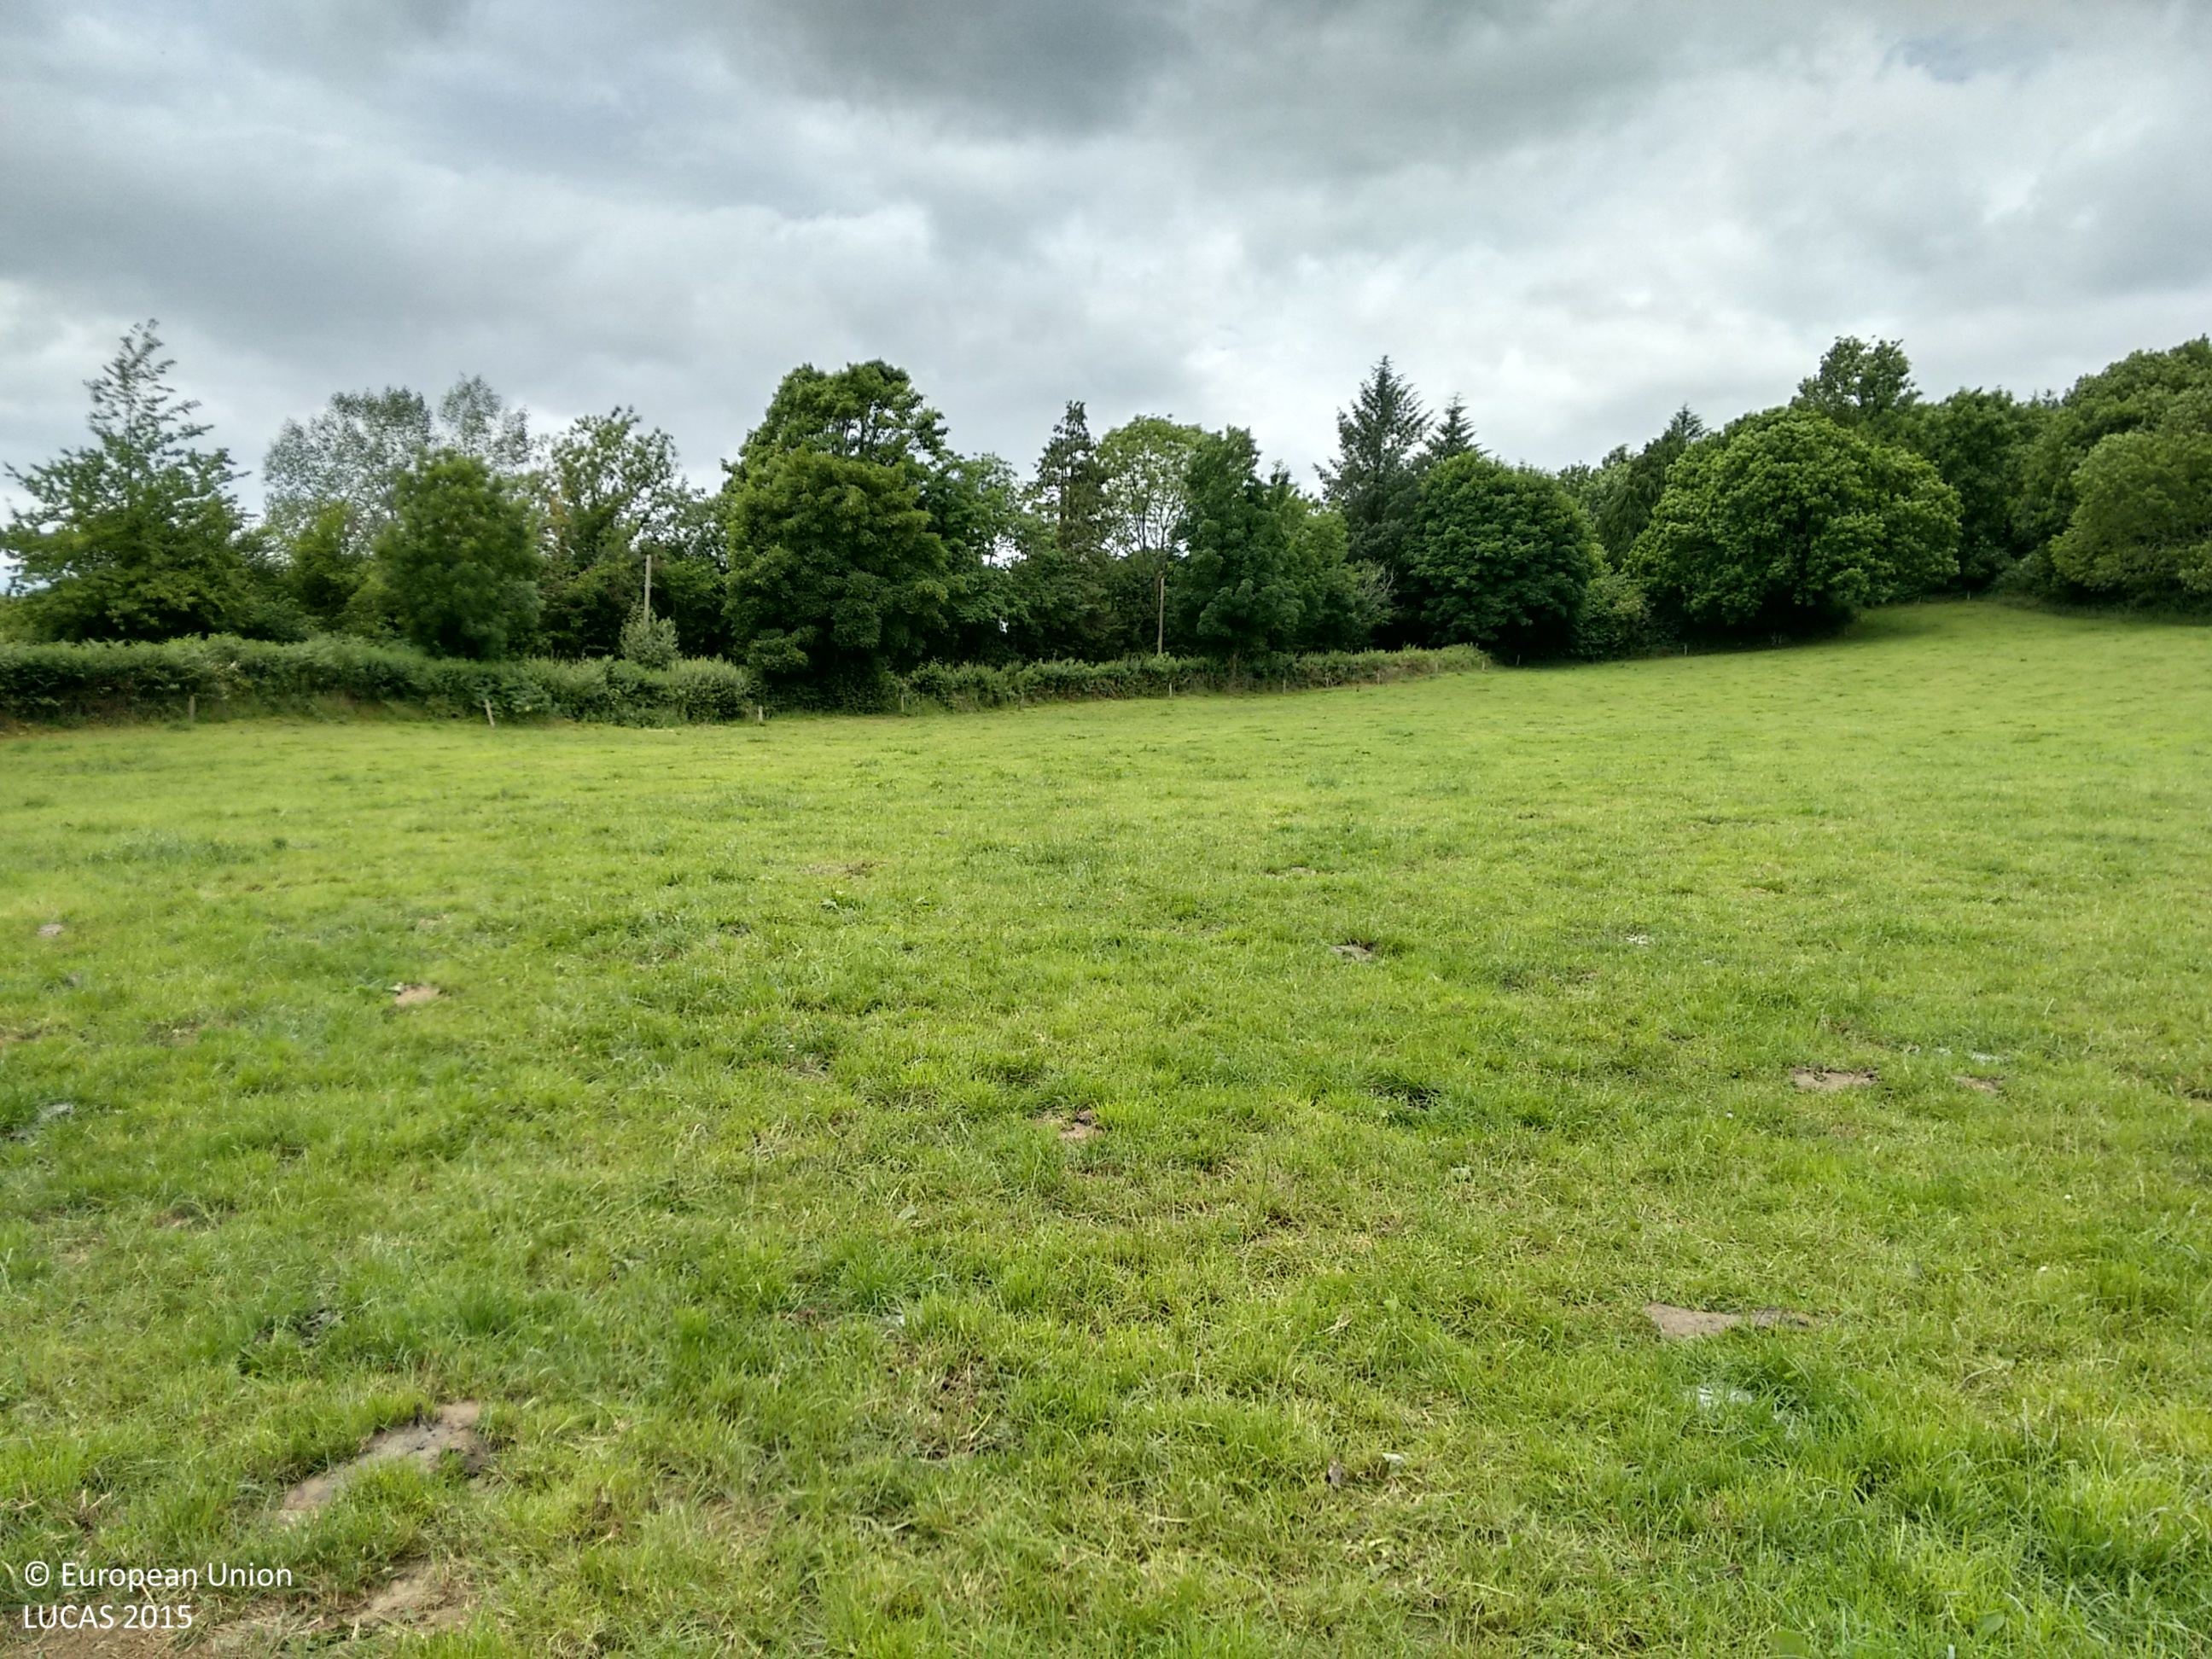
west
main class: Grassland
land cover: Grassland without tree/shrub cover
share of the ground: > 75 %
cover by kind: herbaceous plants 95 %, unconsolidated bare surface 5 %
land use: Agriculture (excluding fallow land and kitchen gardens)
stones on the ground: < 10 %
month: June
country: IE
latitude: 52.4000
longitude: -7.4261
